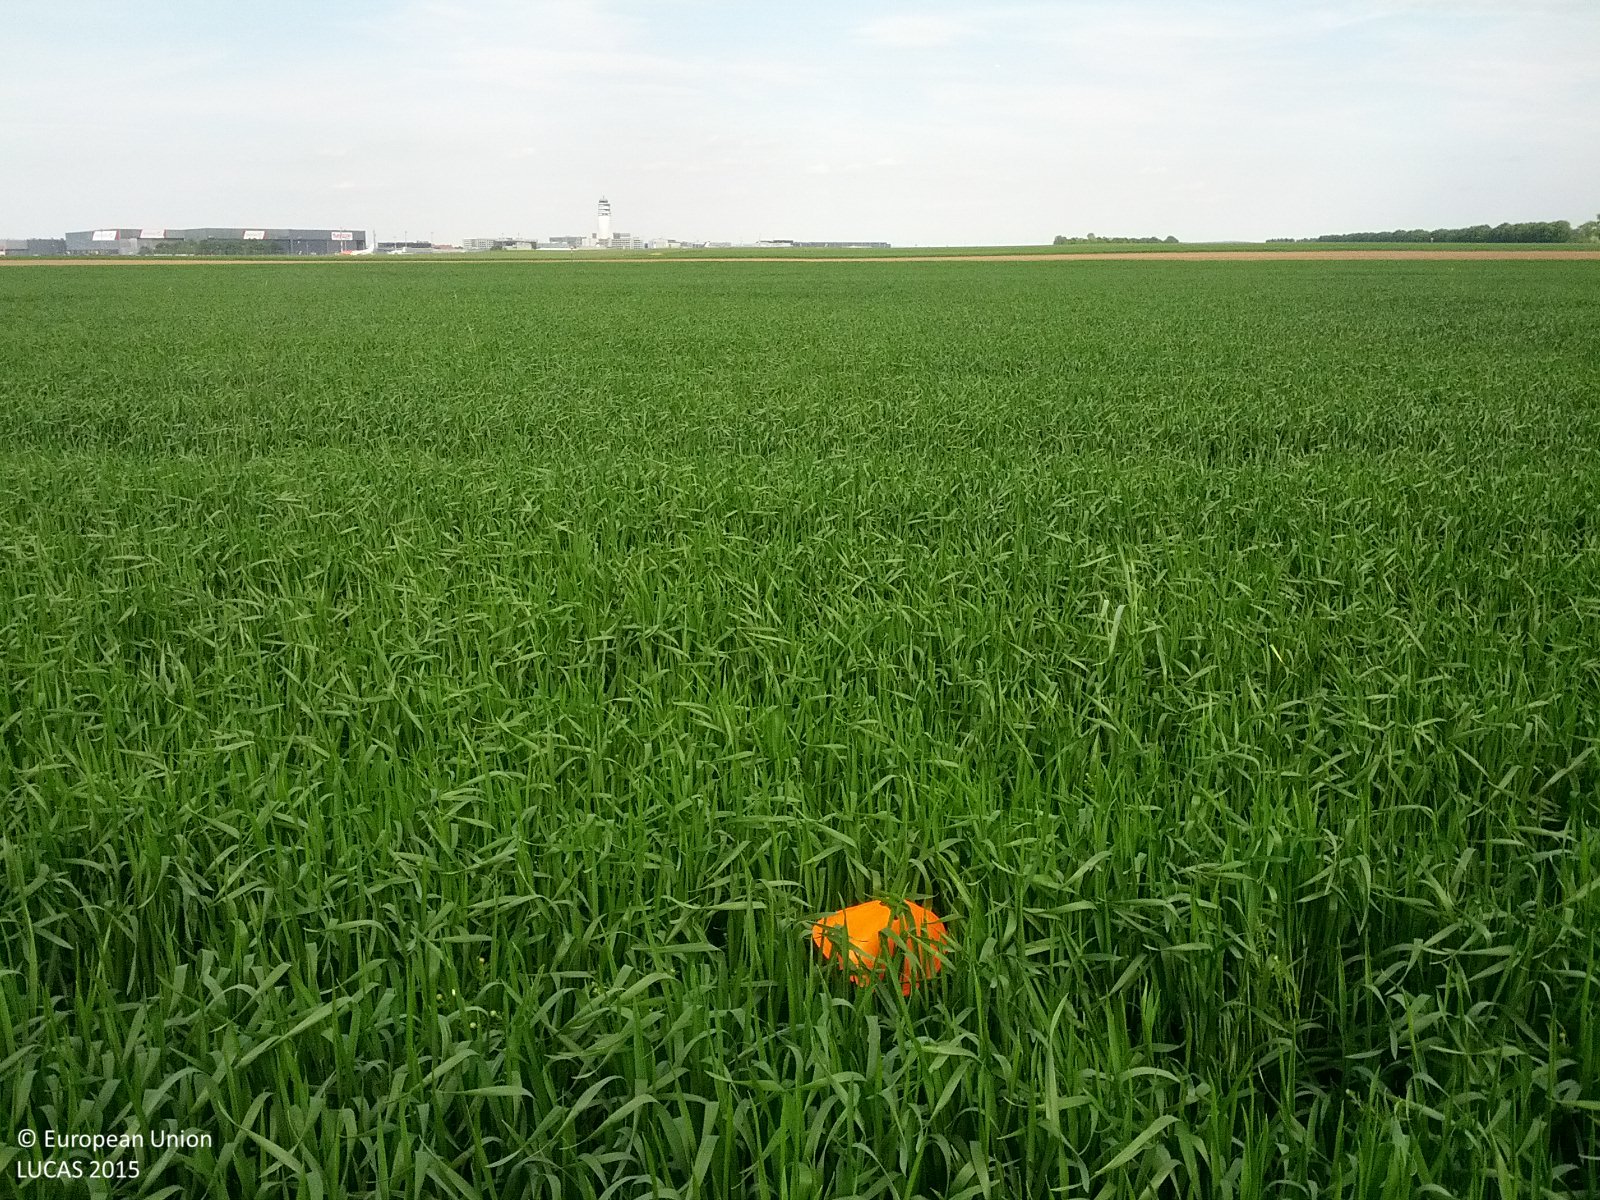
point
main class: Cropland
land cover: Triticale
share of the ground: > 75 %
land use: Agriculture (excluding fallow land and kitchen gardens)
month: May
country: AT
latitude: 48.1207
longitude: 16.5208
